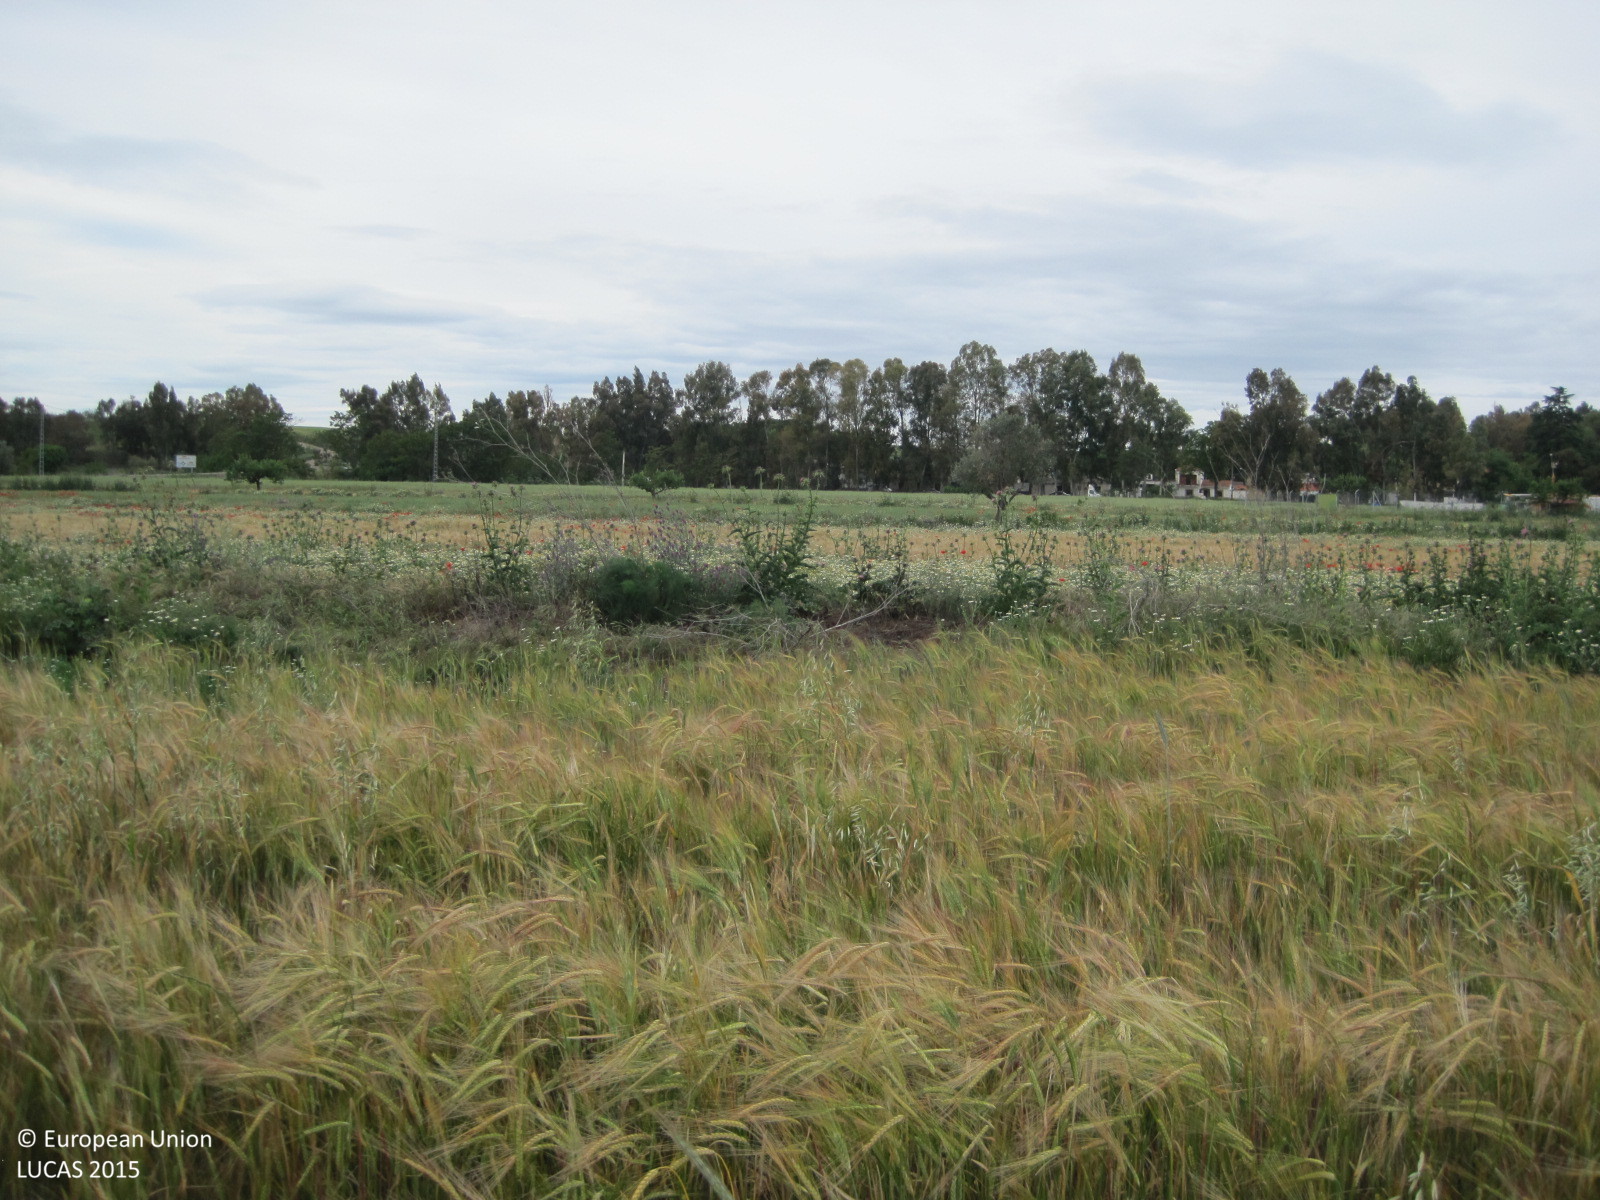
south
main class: Cropland
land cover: Mixed cereals for fodder
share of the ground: > 75 %
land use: Agriculture (excluding fallow land and kitchen gardens)
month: May
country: ES
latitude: 39.9481
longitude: -4.6638
